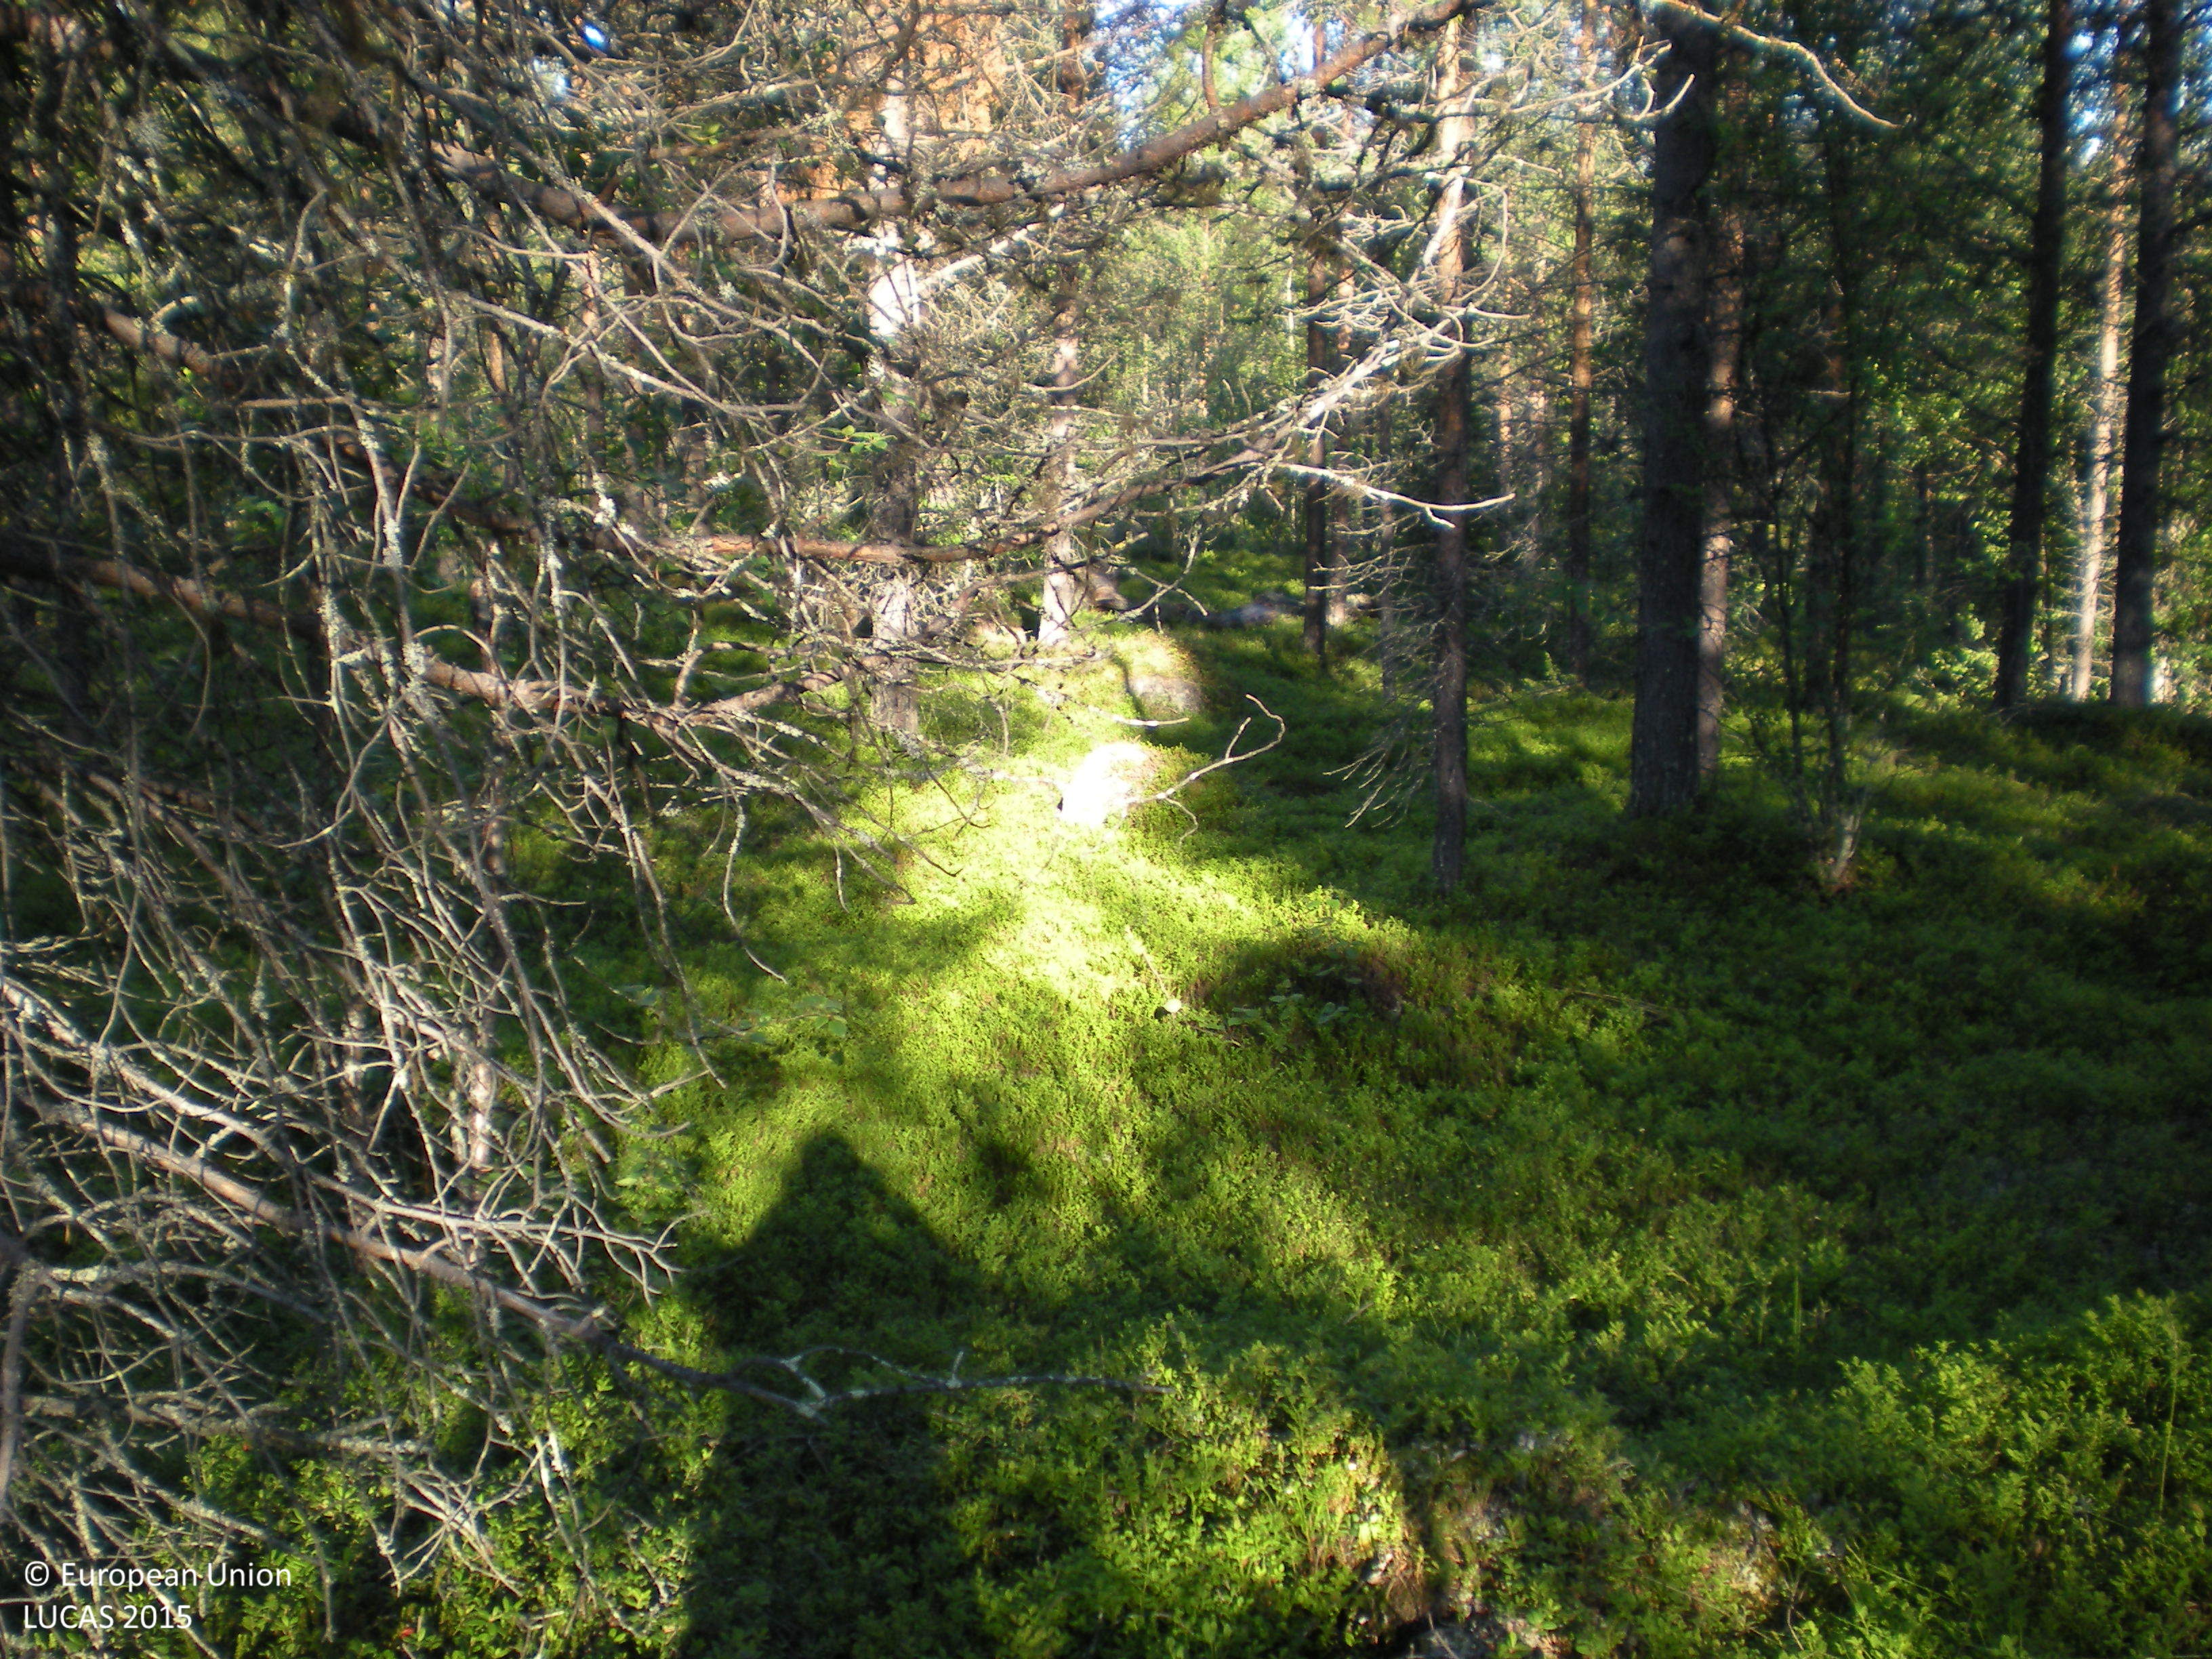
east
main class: Woodland
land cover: Pine dominated coniferous woodland
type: boreal forest
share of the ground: 50 - 75 %
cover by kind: coniferous forest trees 65 %, shrubs 25 %, broadleaved forest trees 5 %, lichens and mosses 5 %
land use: Forestry
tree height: > 5 m
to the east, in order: Pine dominated coniferous woodland; Pine dominated mixed woodland; Pine dominated coniferous woodland; Shruby margins; Tracks; Shruby margins; Pine dominated mixed woodland; Pine dominated coniferous woodland
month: August
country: SE
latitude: 66.3189
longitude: 18.0967
